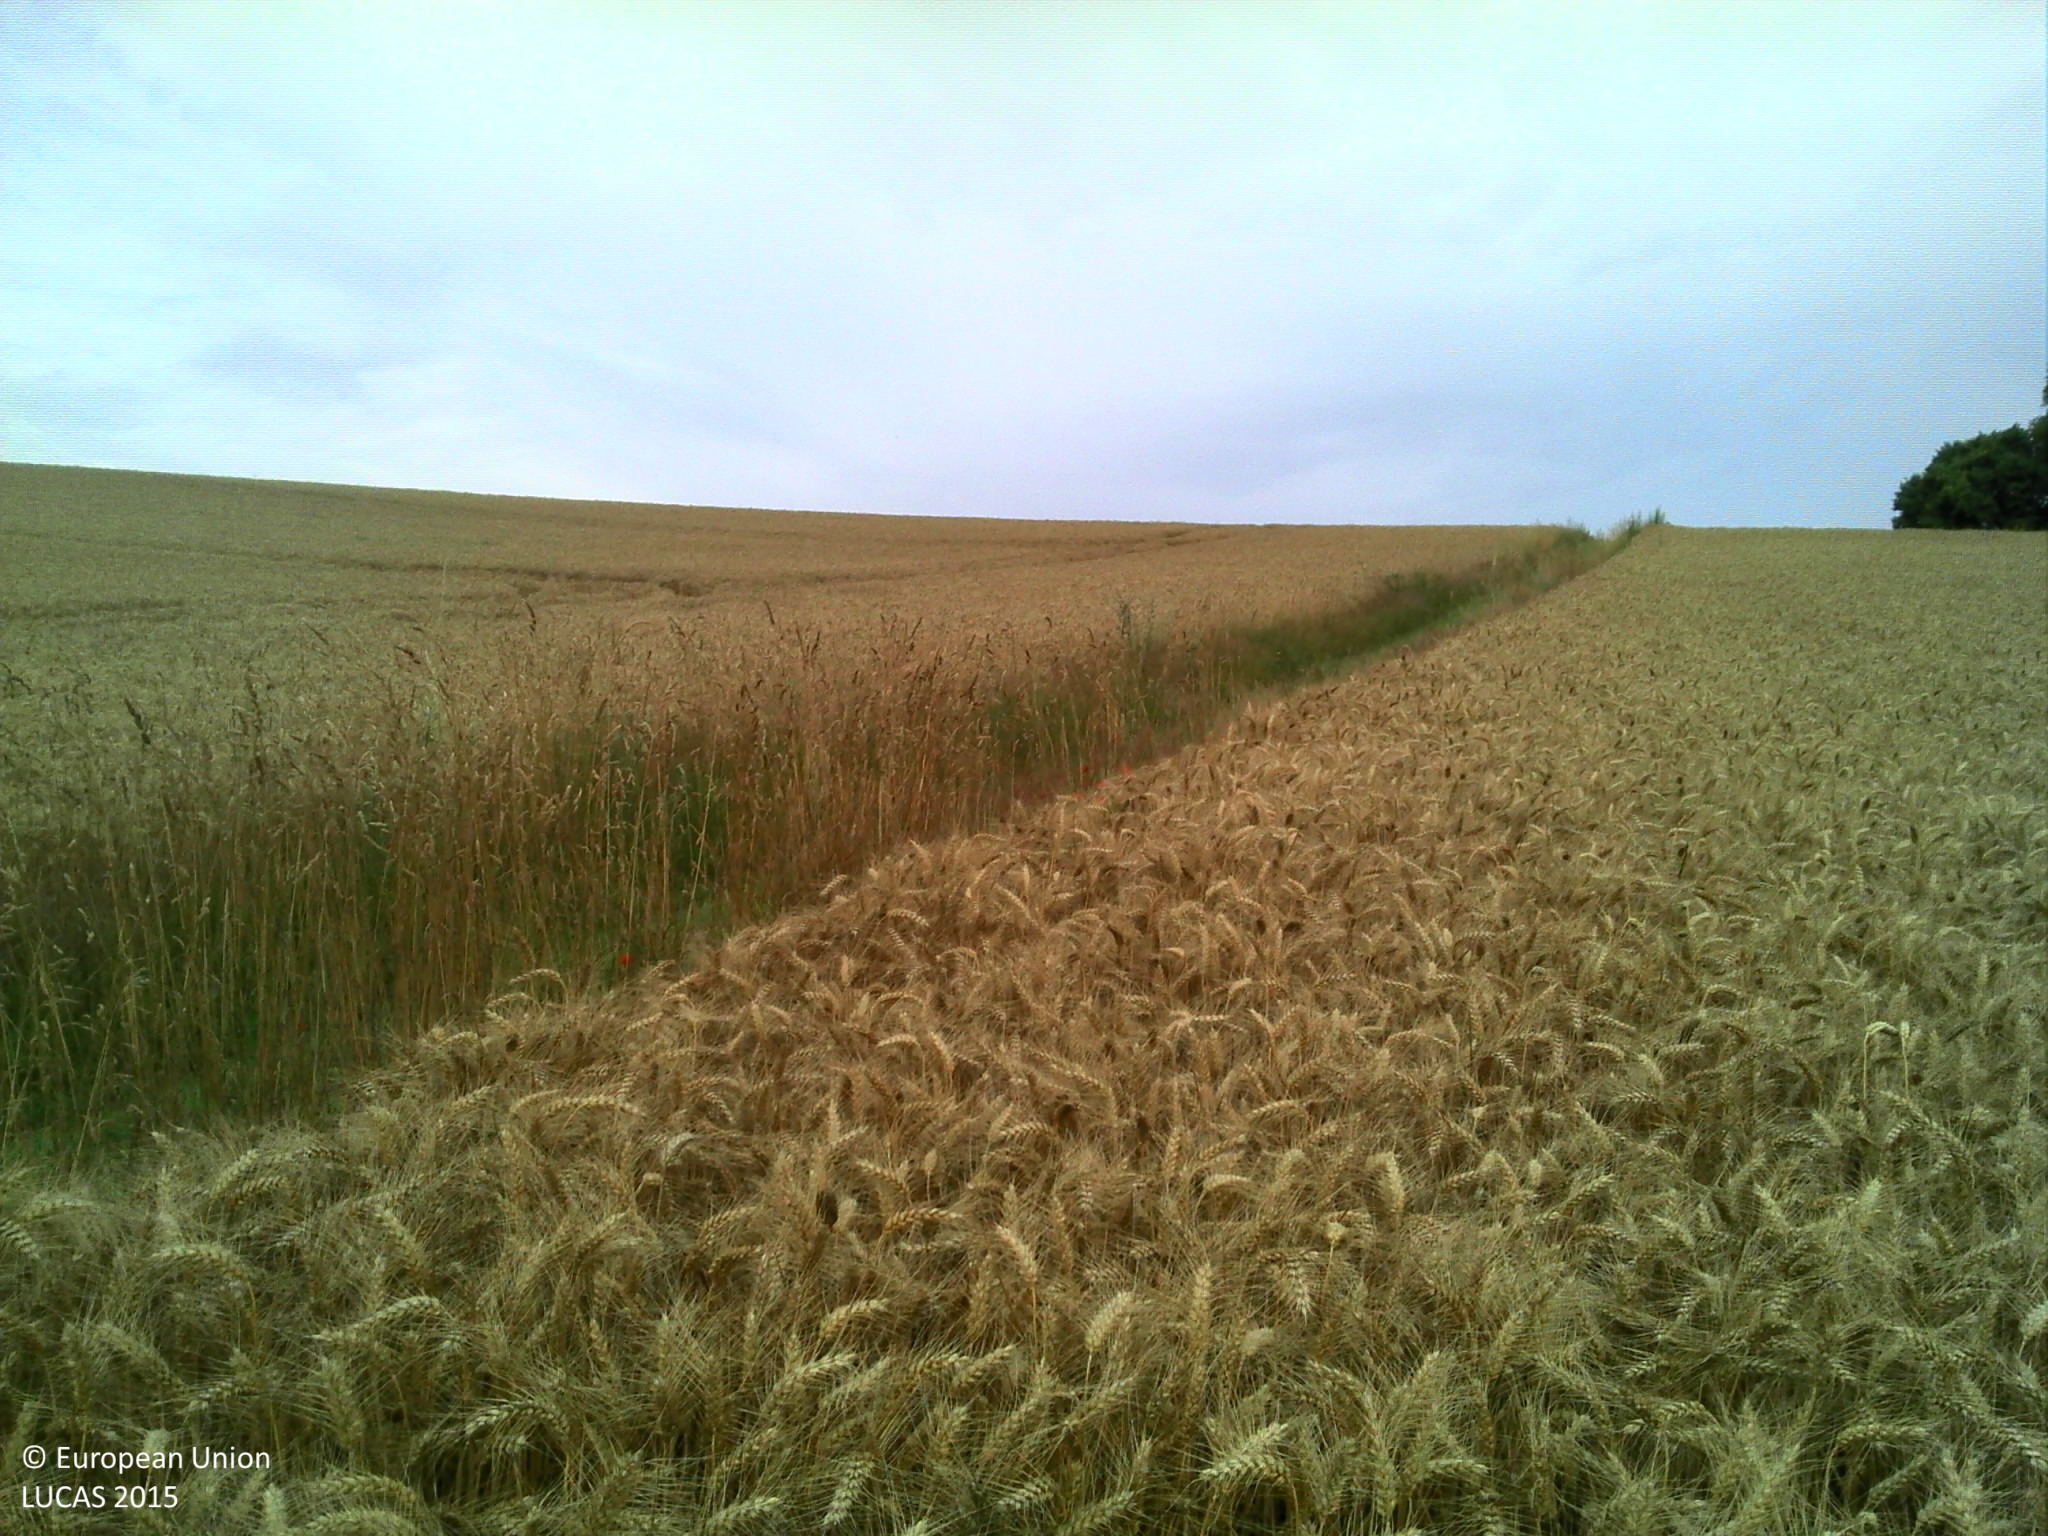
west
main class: Cropland
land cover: Durum wheat
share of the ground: > 75 %
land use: Agriculture (excluding fallow land and kitchen gardens)
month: July
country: FR
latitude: 50.0579
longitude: 2.1495
